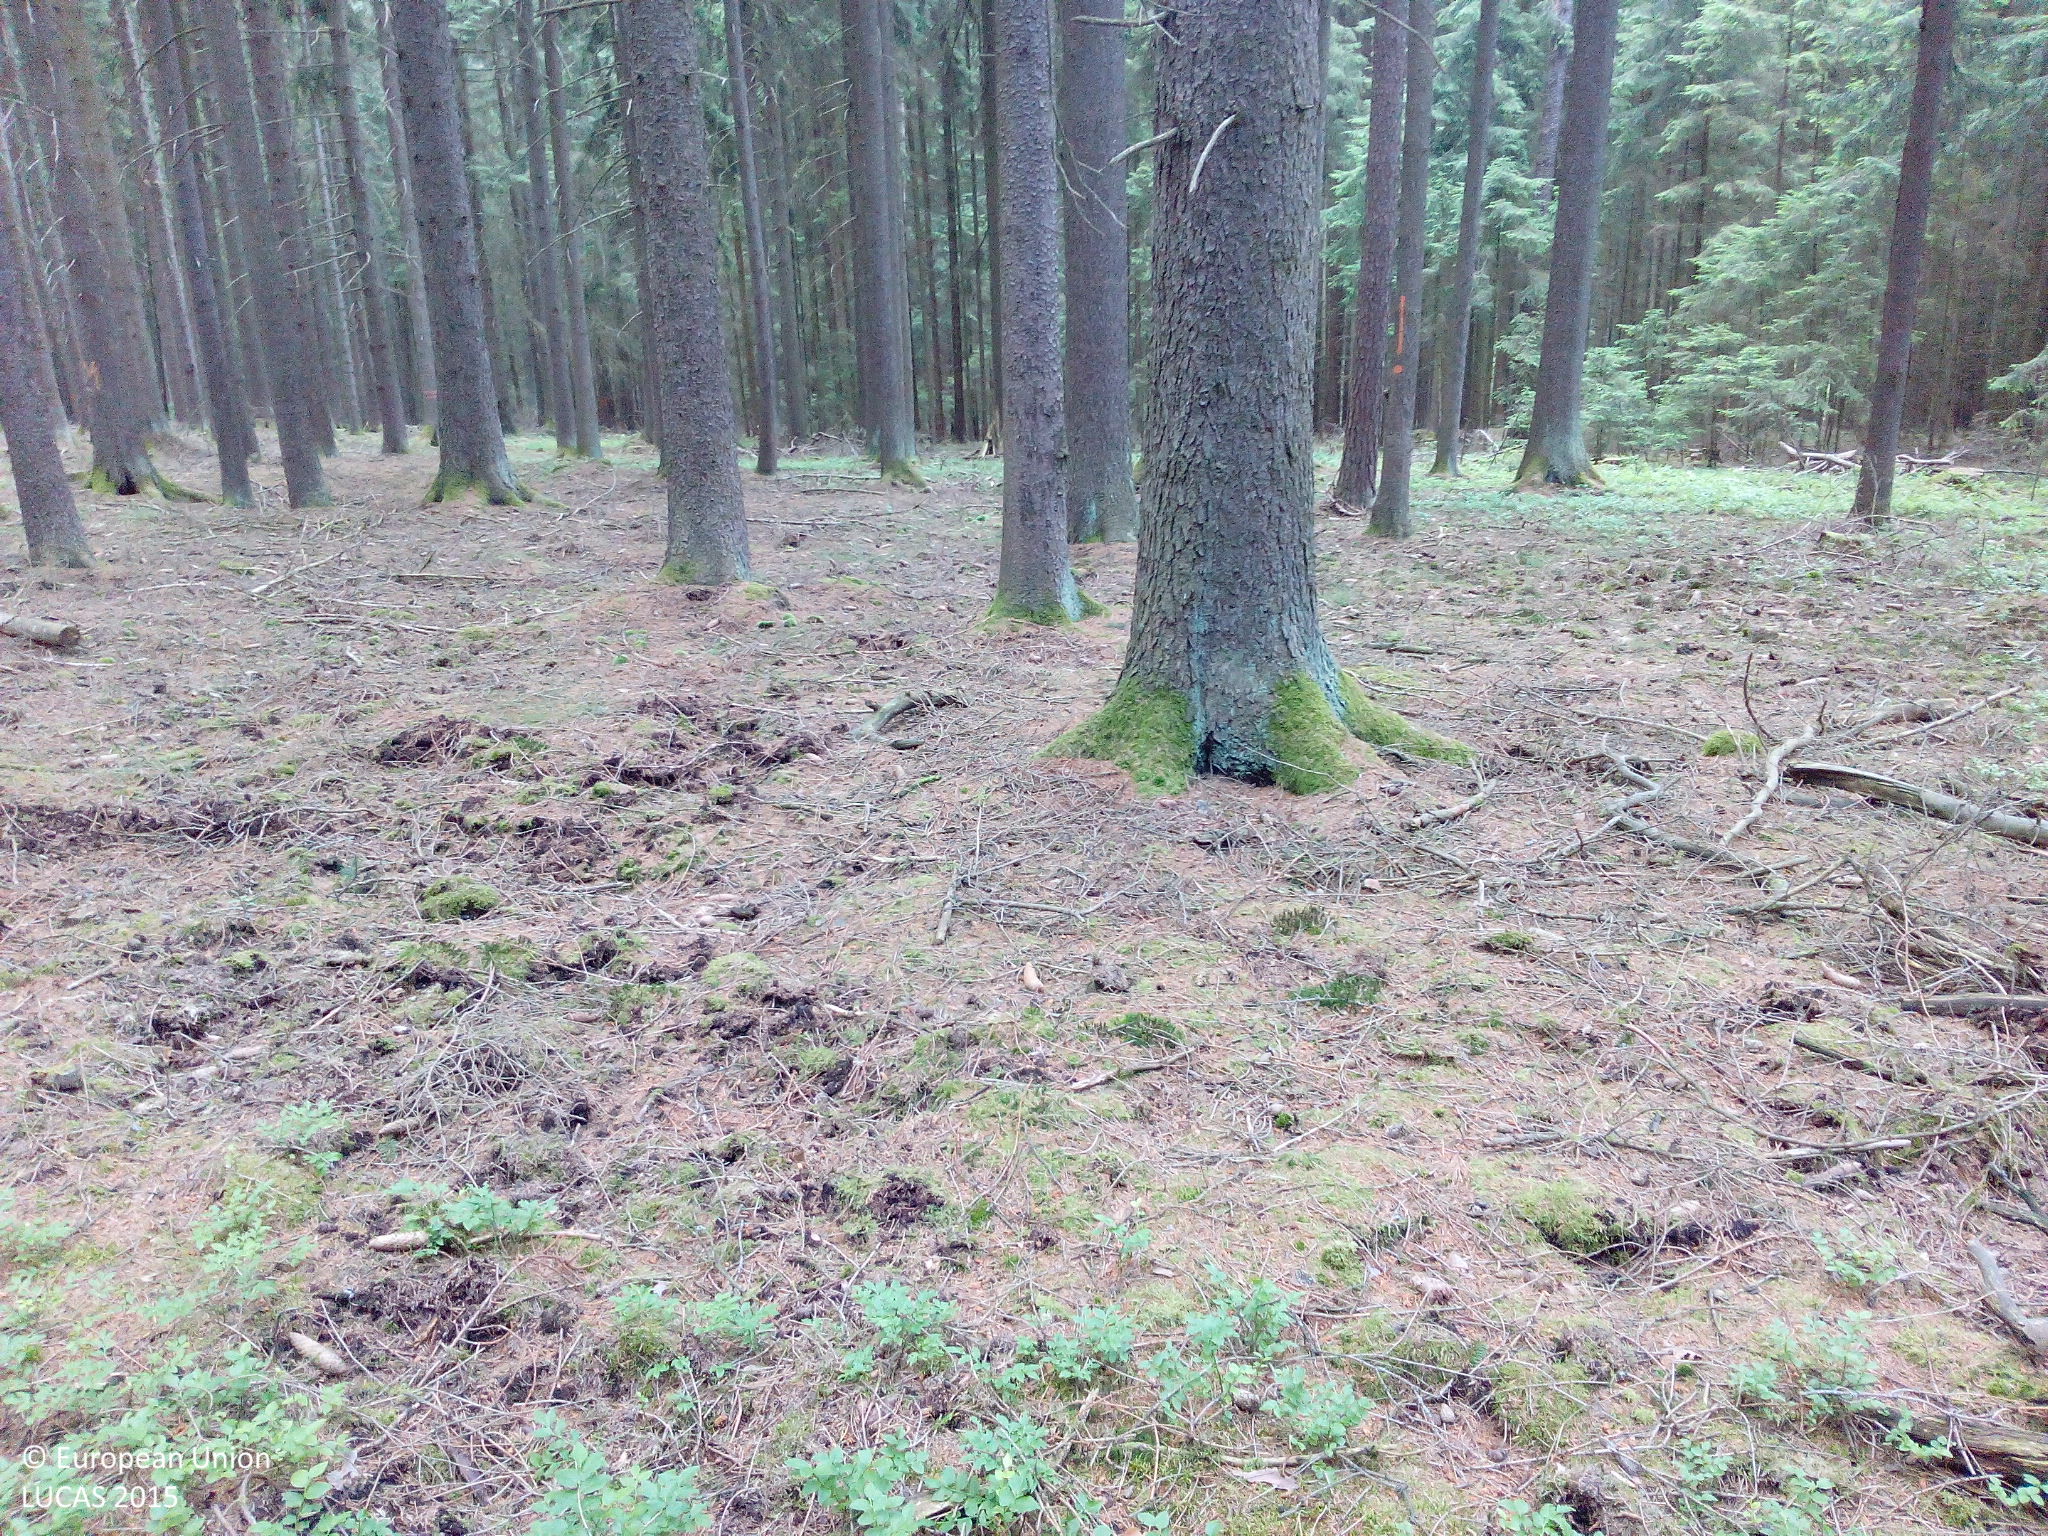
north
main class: Woodland
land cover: Spruce dominated coniferous woodland
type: hemiboreal forest and nemoral coniferous forest and mixed broadleaved-coniferous forest
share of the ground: 50 - 75 %
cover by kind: coniferous forest trees 70 %, herbaceous plants 10 %, lichens and mosses 10 %, unconsolidated bare surface 10 %
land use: Forestry
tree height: > 5 m
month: June
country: DE
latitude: 48.9267
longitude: 11.9238
